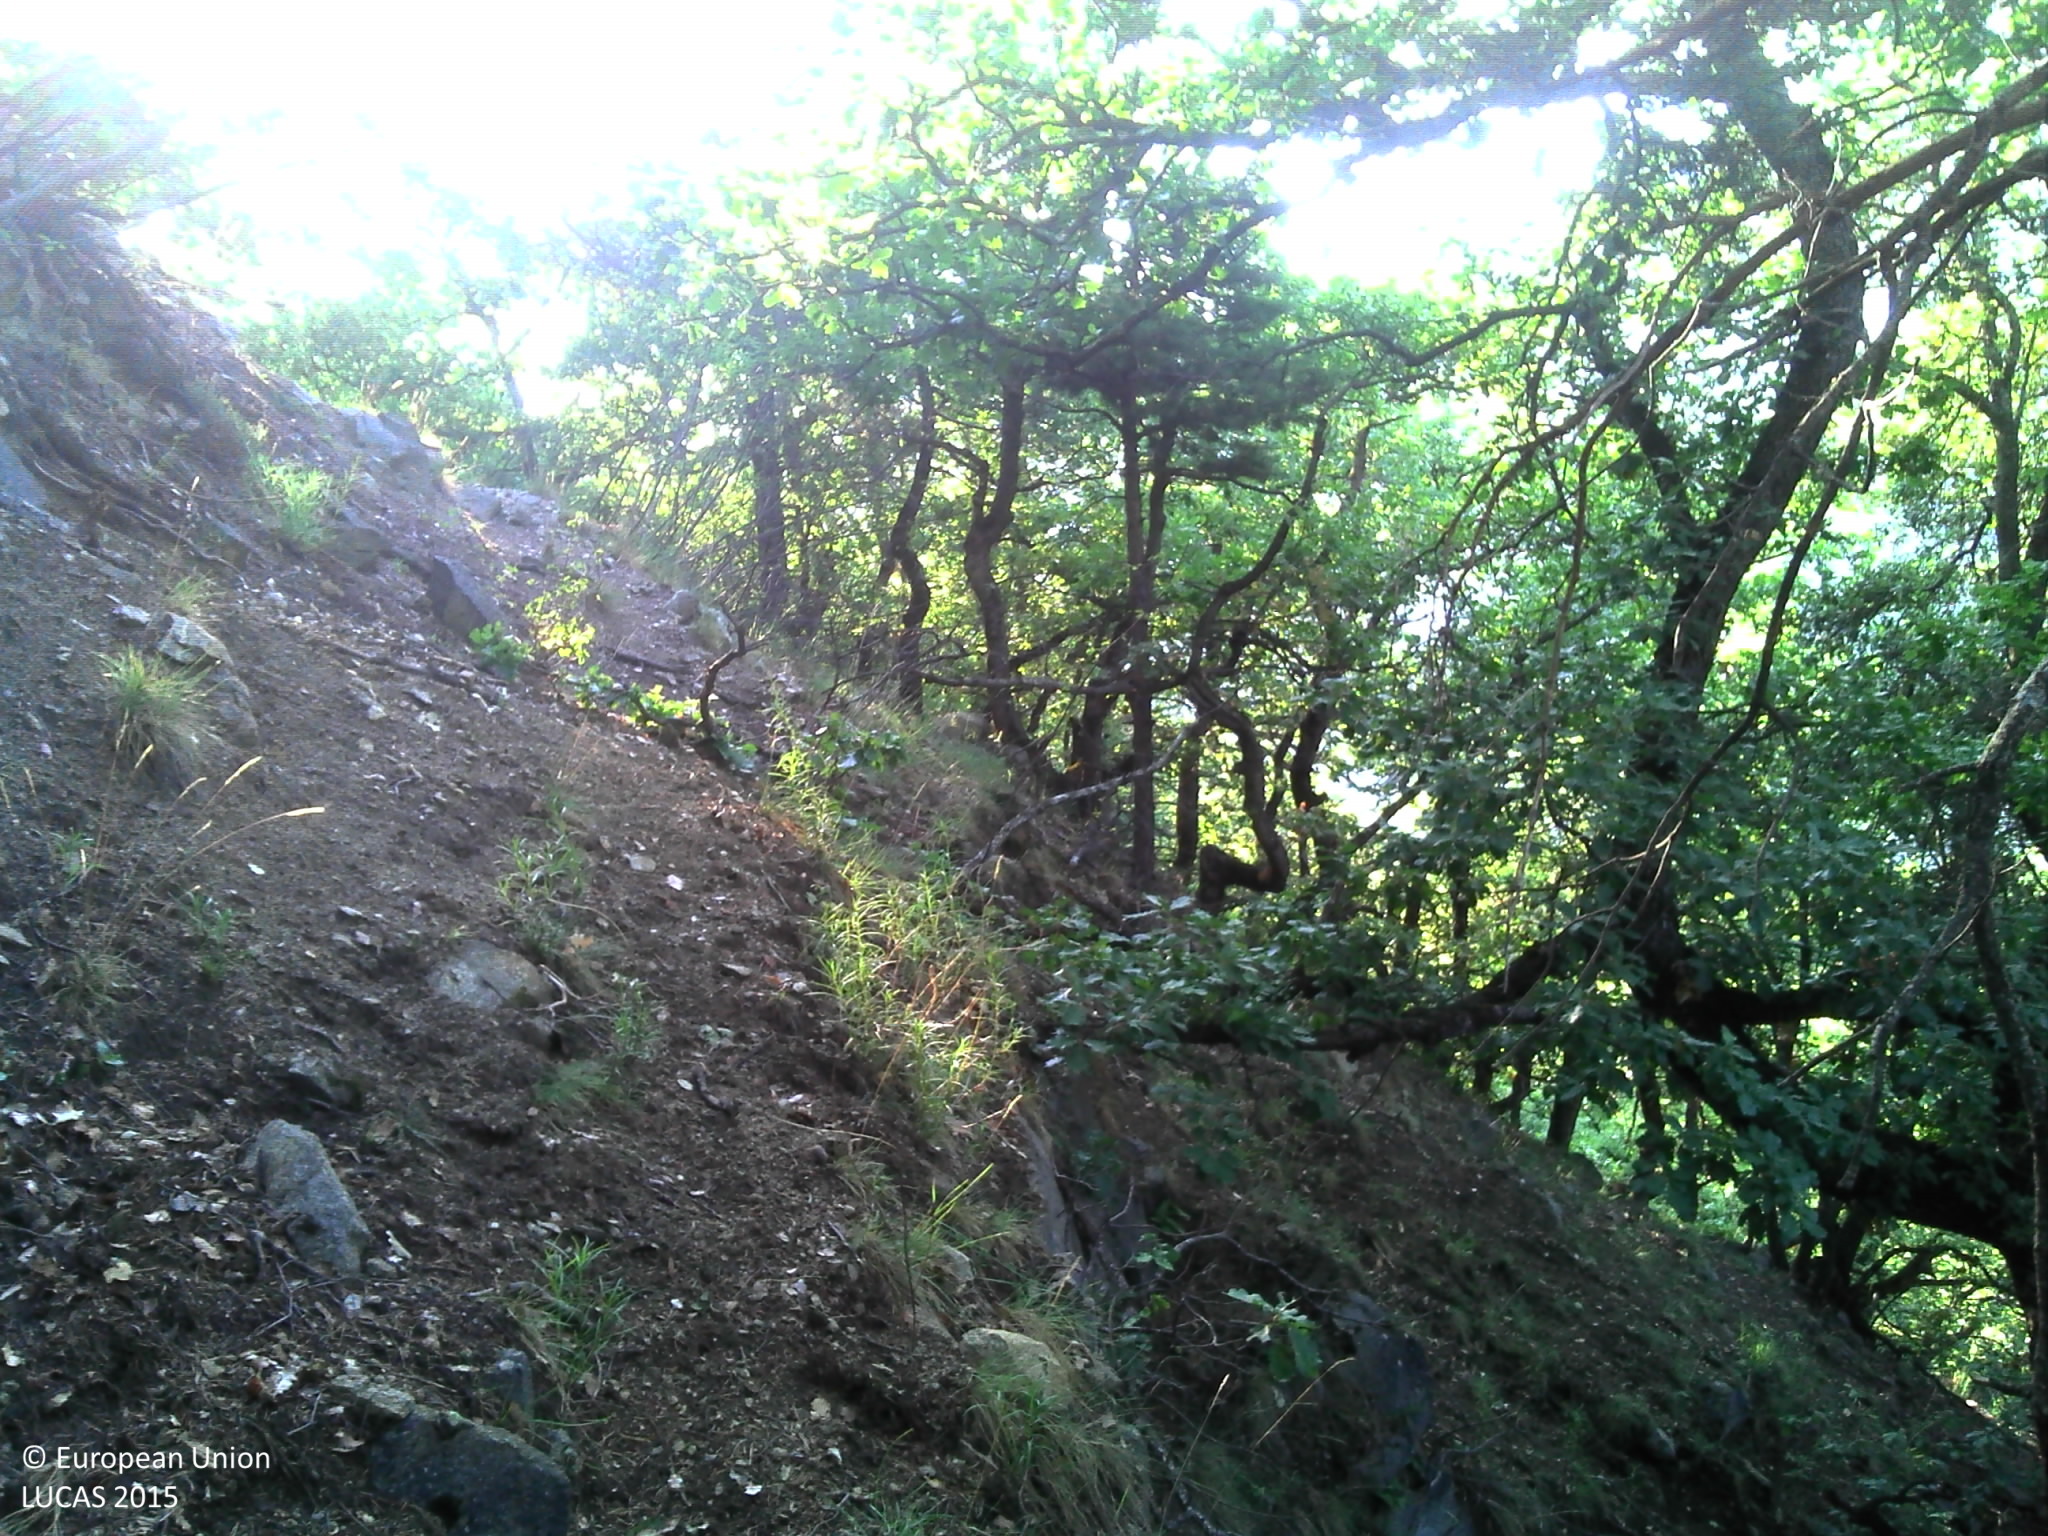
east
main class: Woodland
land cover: Pine dominated mixed woodland
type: mesophytic deciduous forest
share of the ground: > 75 %
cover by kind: broadleaved forest trees 55 %, coniferous forest trees 40 %, unconsolidated bare surface 5 %
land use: Semi-natural and natural areas not in use
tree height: > 5 m
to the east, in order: Pine dominated mixed woodland; Rivers and streams; Broadleaved woodland; Fences; Broadleaved woodland; Dry stone walls; Broadleaved woodland; Grassland with sparse tree/shrub cover; Dry stone walls; Grassland with sparse tree/shrub cover; Dry stone walls; Electric lines
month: July
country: FR
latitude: 42.5150
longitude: 2.1851
